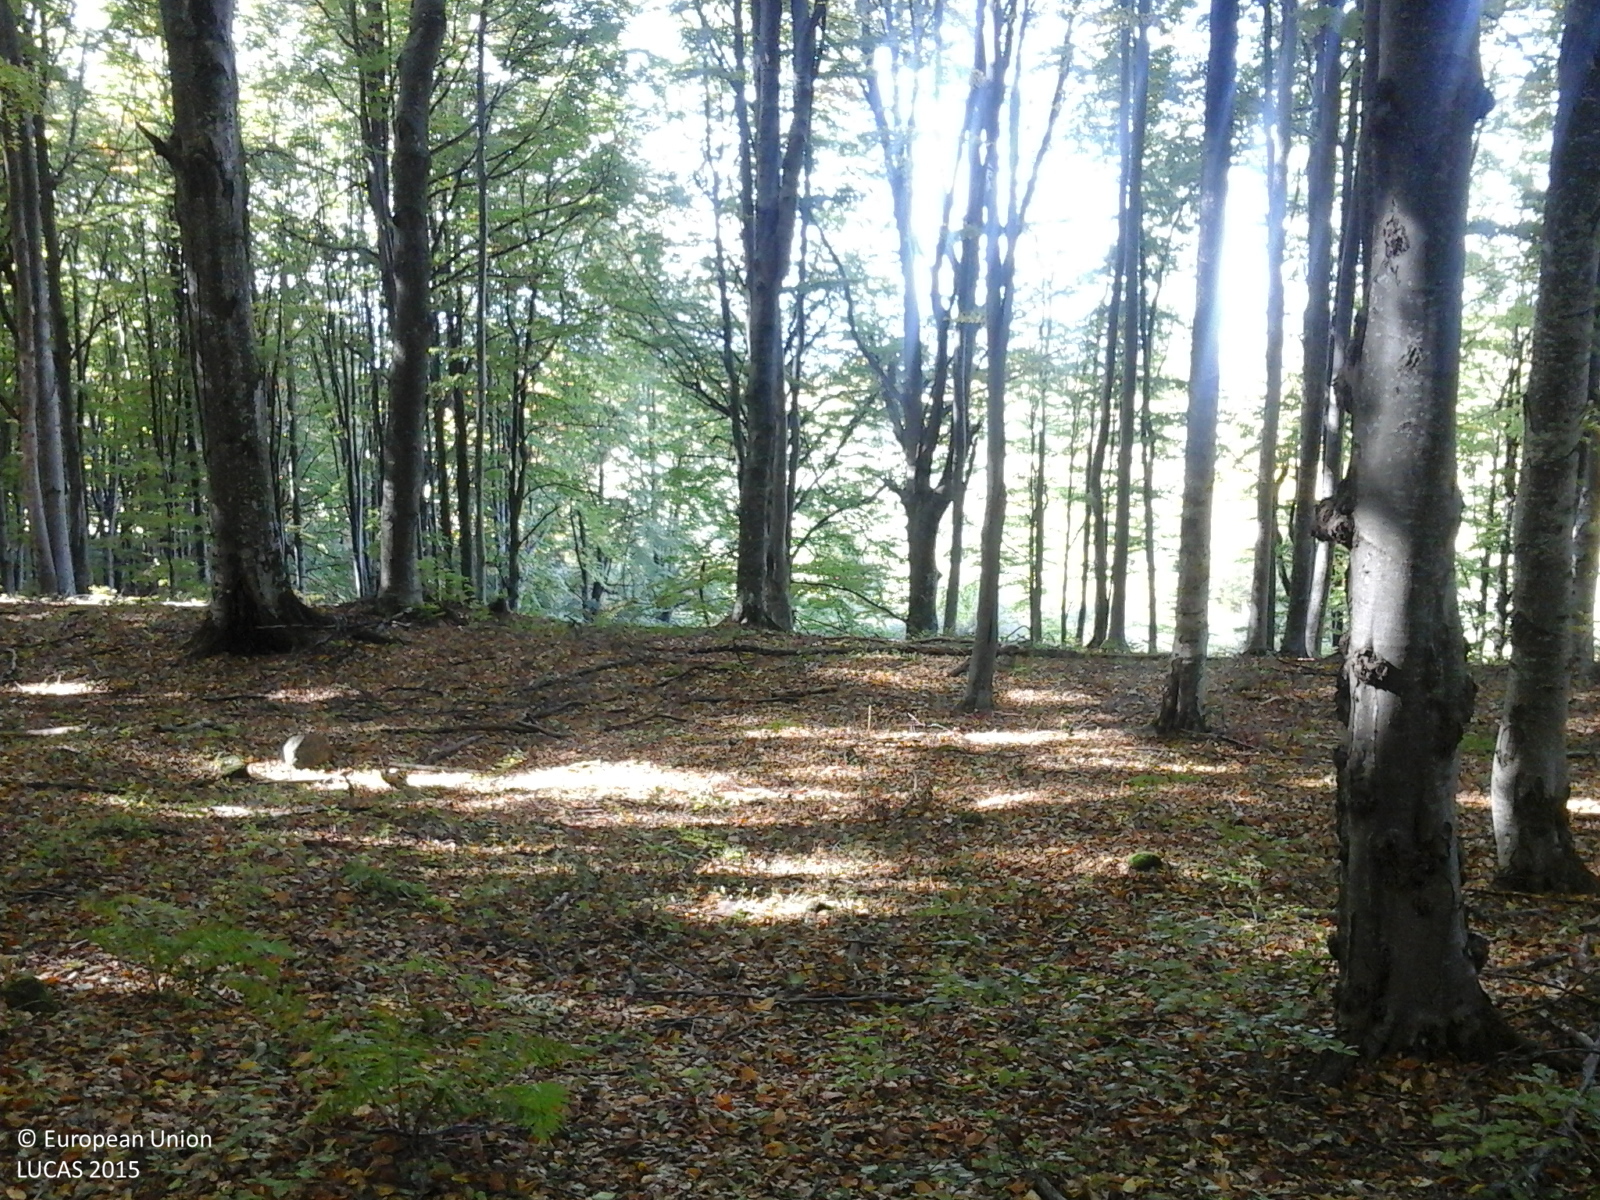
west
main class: Woodland
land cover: Broadleaved woodland
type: beech forest
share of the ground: > 75 %
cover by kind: broadleaved forest trees 100 %
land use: Forestry
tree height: > 5 m
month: October
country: RO
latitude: 46.5412
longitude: 25.0559
